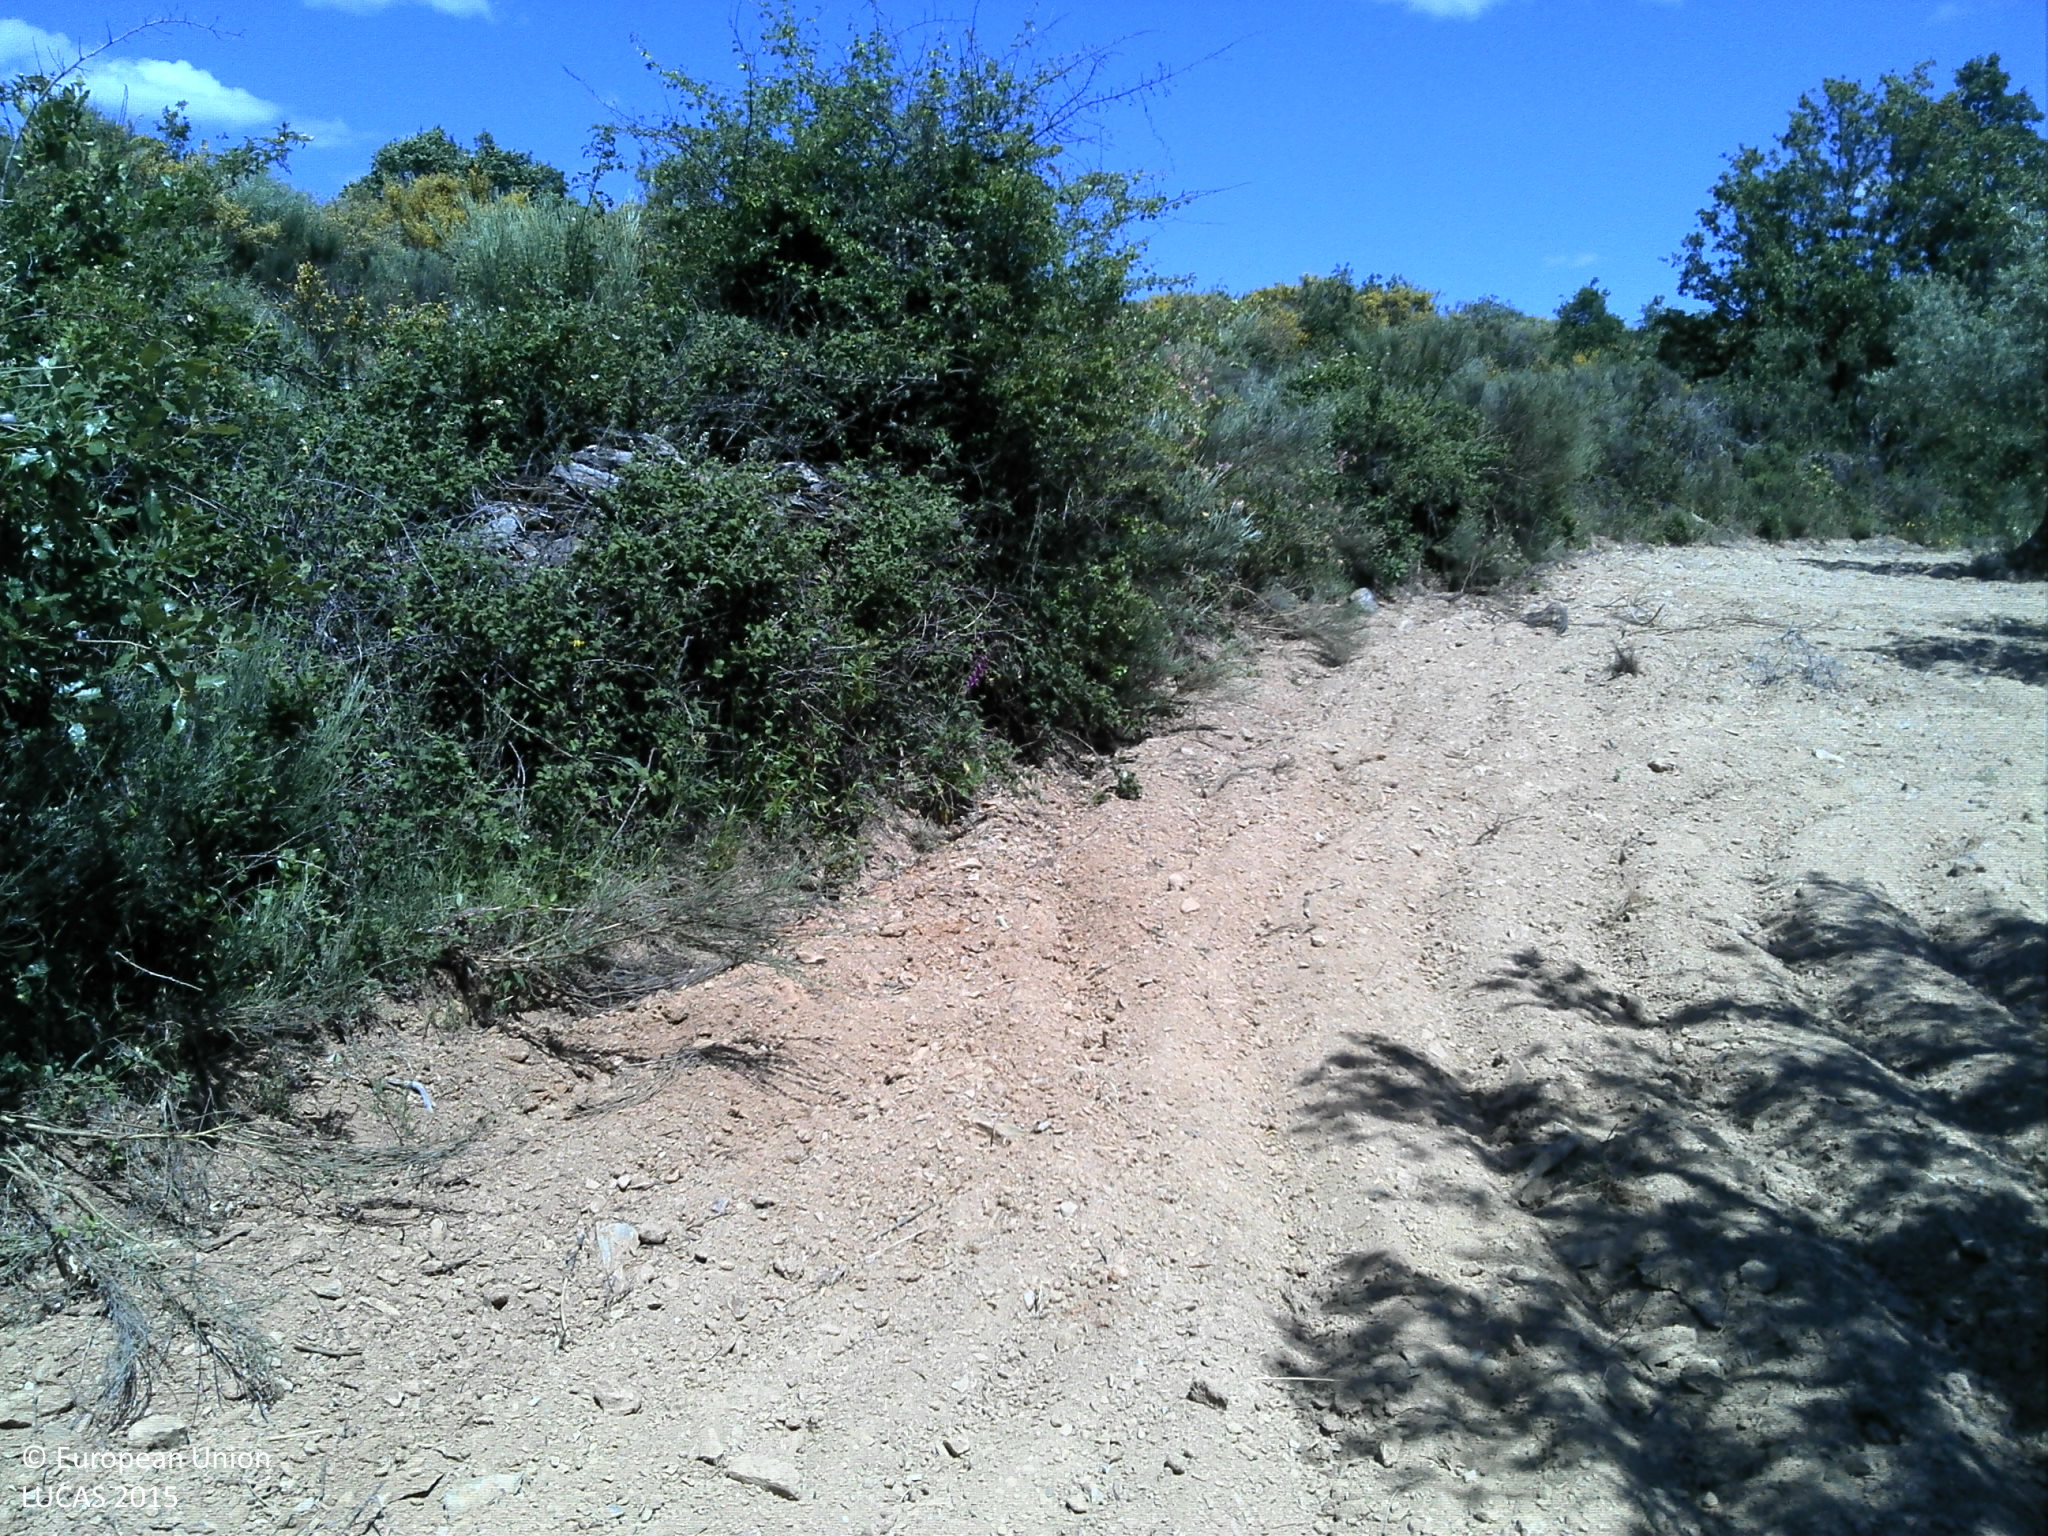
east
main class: Cropland
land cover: Olive groves
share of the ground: < 10 %
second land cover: Other bare soil
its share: > 75 %
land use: Agriculture (excluding fallow land and kitchen gardens)
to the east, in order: Olive groves; Other bare soil; Olive groves; Shruby margins; Dry stone walls; Shruby margins; Tracks; Shrubland with sparse tree cover; Shrubland without tree cover; Tracks; Spontaneously vegetated surfaces; Olive groves
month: May
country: PT
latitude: 41.6465
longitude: -6.5674
